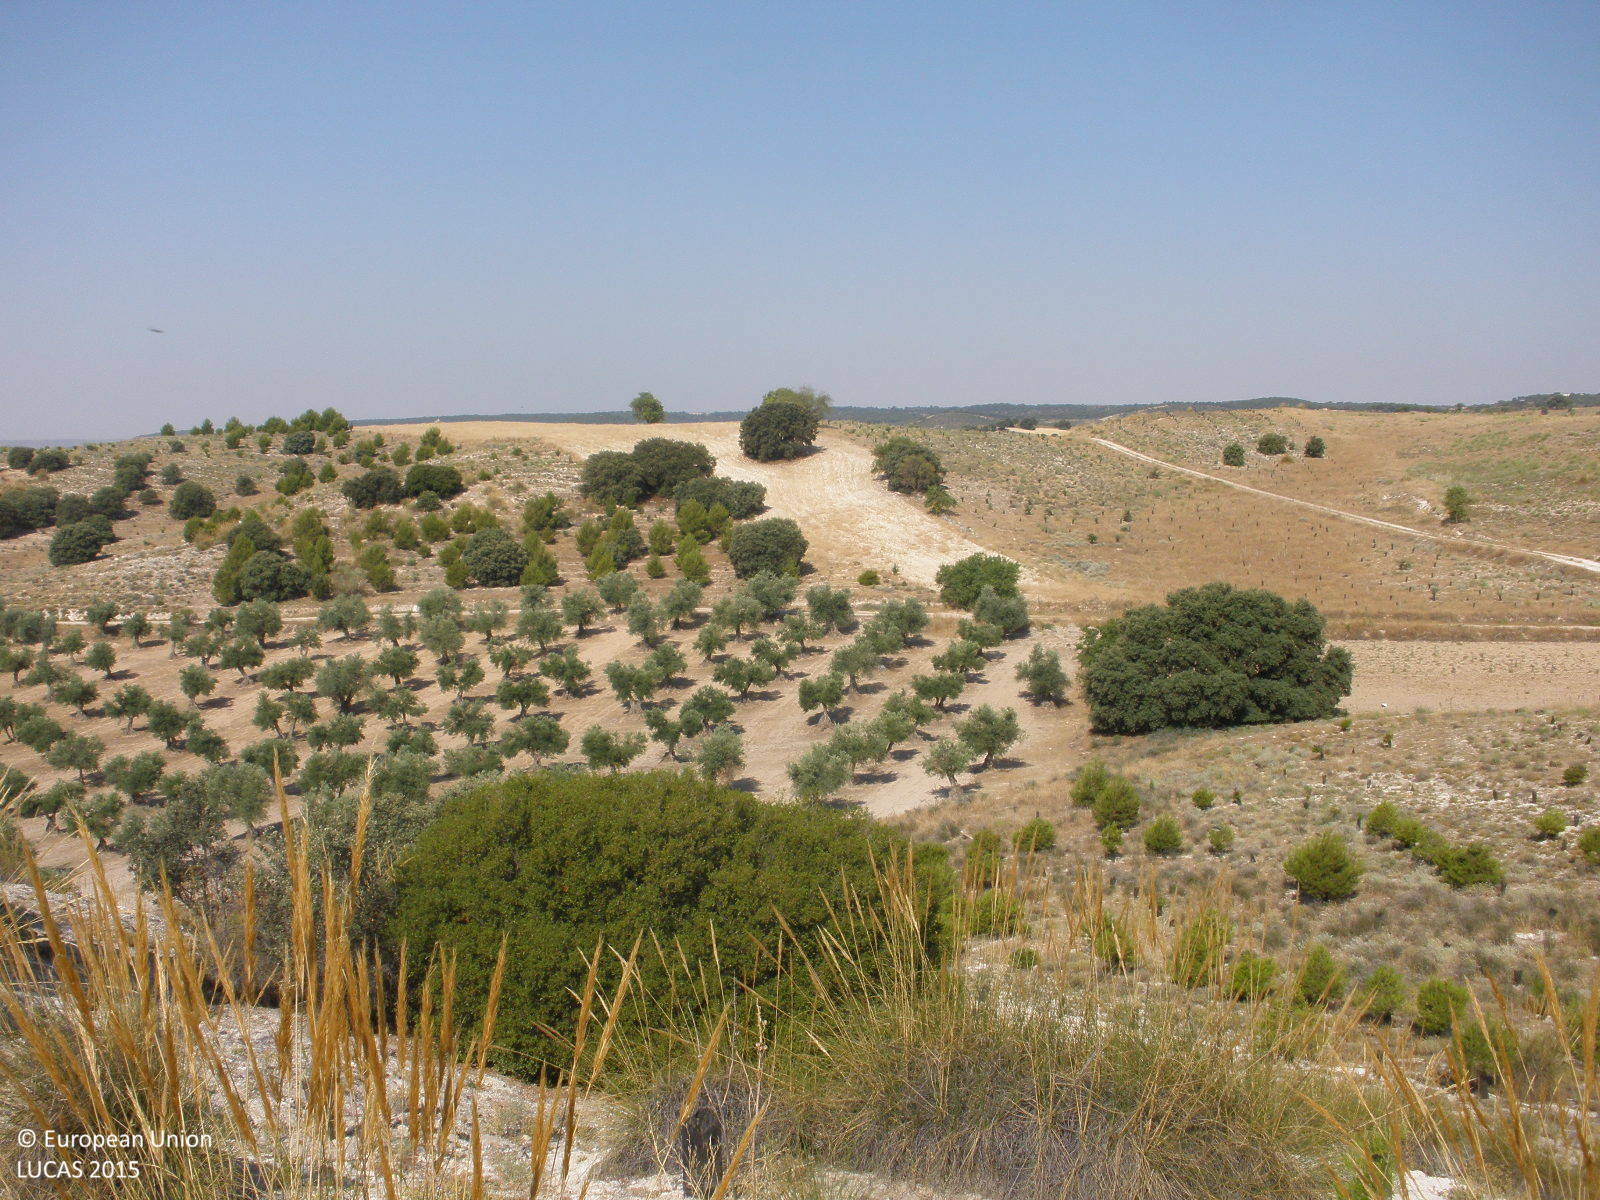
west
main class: Woodland
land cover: Broadleaved woodland
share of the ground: 25 - 50 %
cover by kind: shrubs 35 %, broadleaved forest trees 30 %, consolidated bare surface 25 %, herbaceous plants 10 %
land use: Semi-natural and natural areas not in use
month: June
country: ES
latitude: 40.1116
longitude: -3.2740
